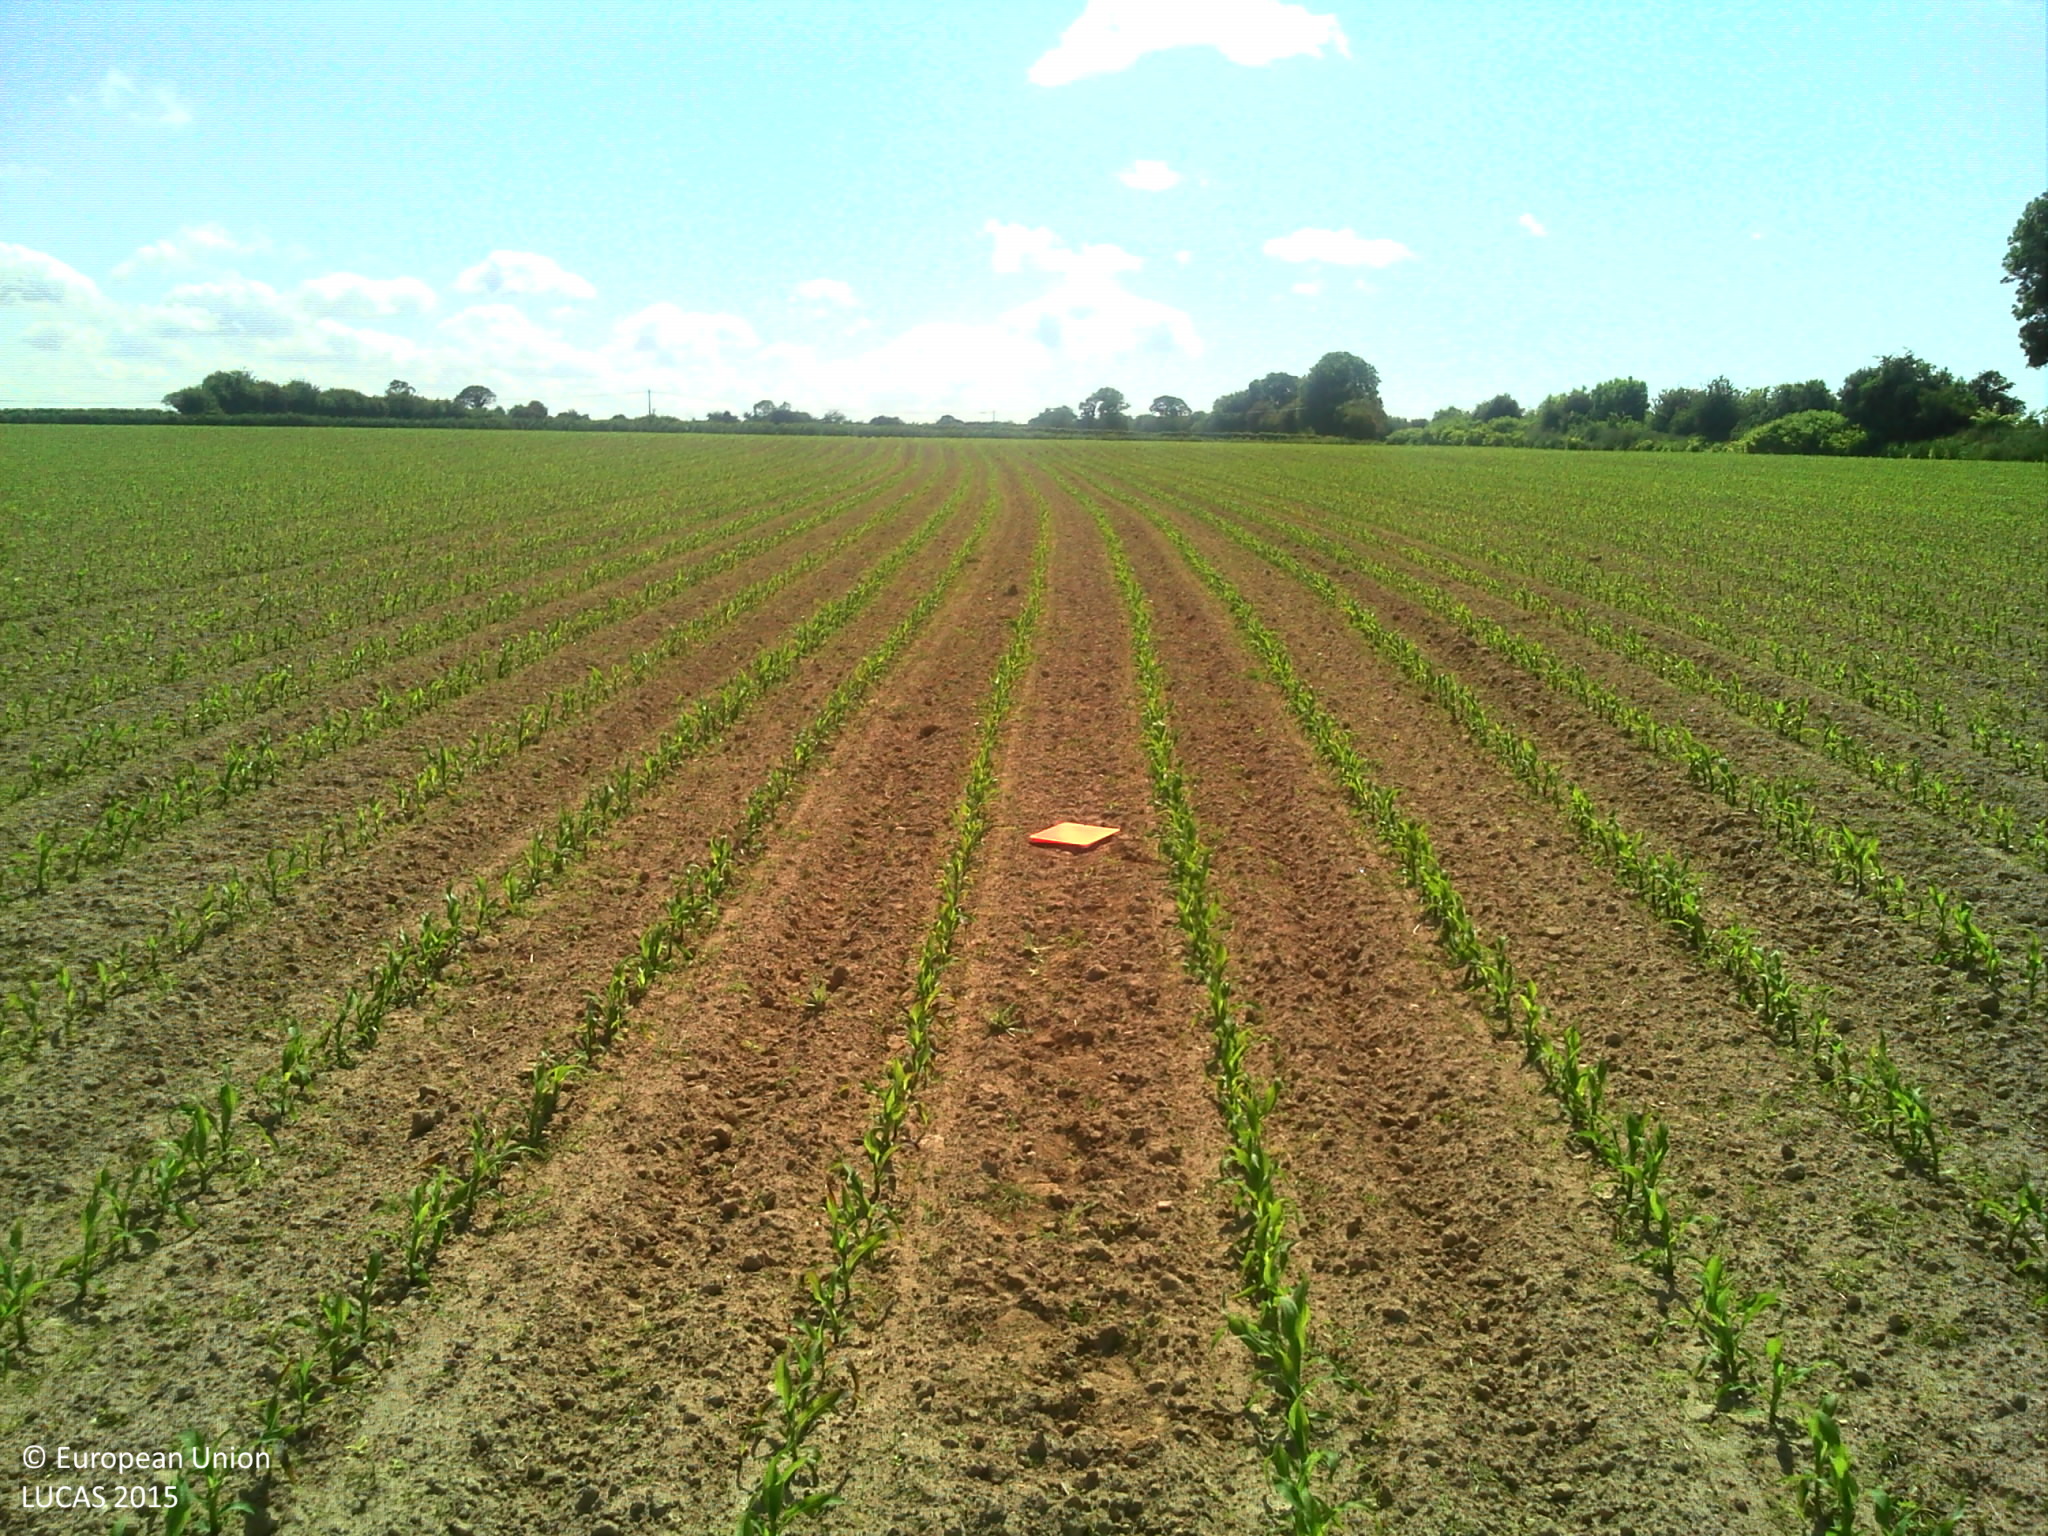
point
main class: Cropland
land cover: Maize
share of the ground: 10 - 25 %
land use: Agriculture (excluding fallow land and kitchen gardens)
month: June
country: FR
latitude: 49.6597
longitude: -1.4502
